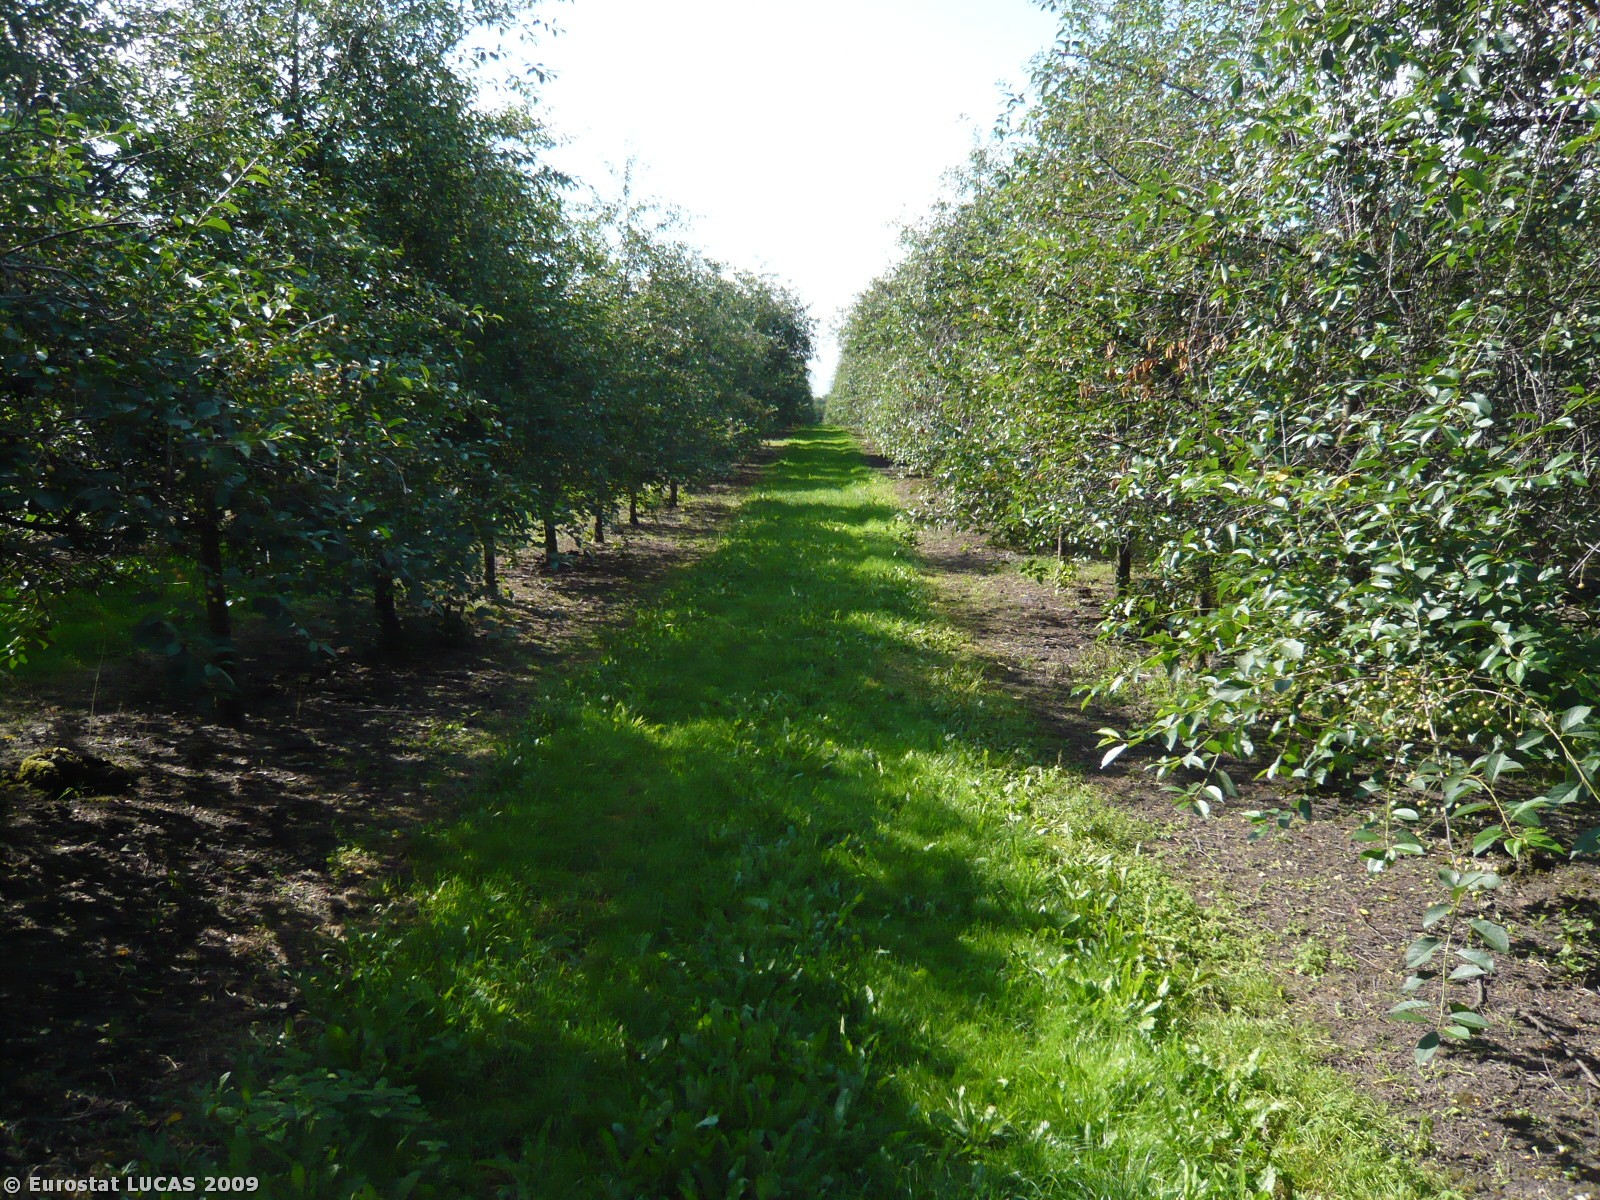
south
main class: Cropland
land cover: Cherry fruit
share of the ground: 50 - 75 %
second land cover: Grassland with sparse tree/shrub cover
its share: 25 - 50 %
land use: Agriculture (excluding fallow land and kitchen gardens)
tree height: < 5 m
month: July
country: DK
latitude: 55.3586
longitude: 10.7722
